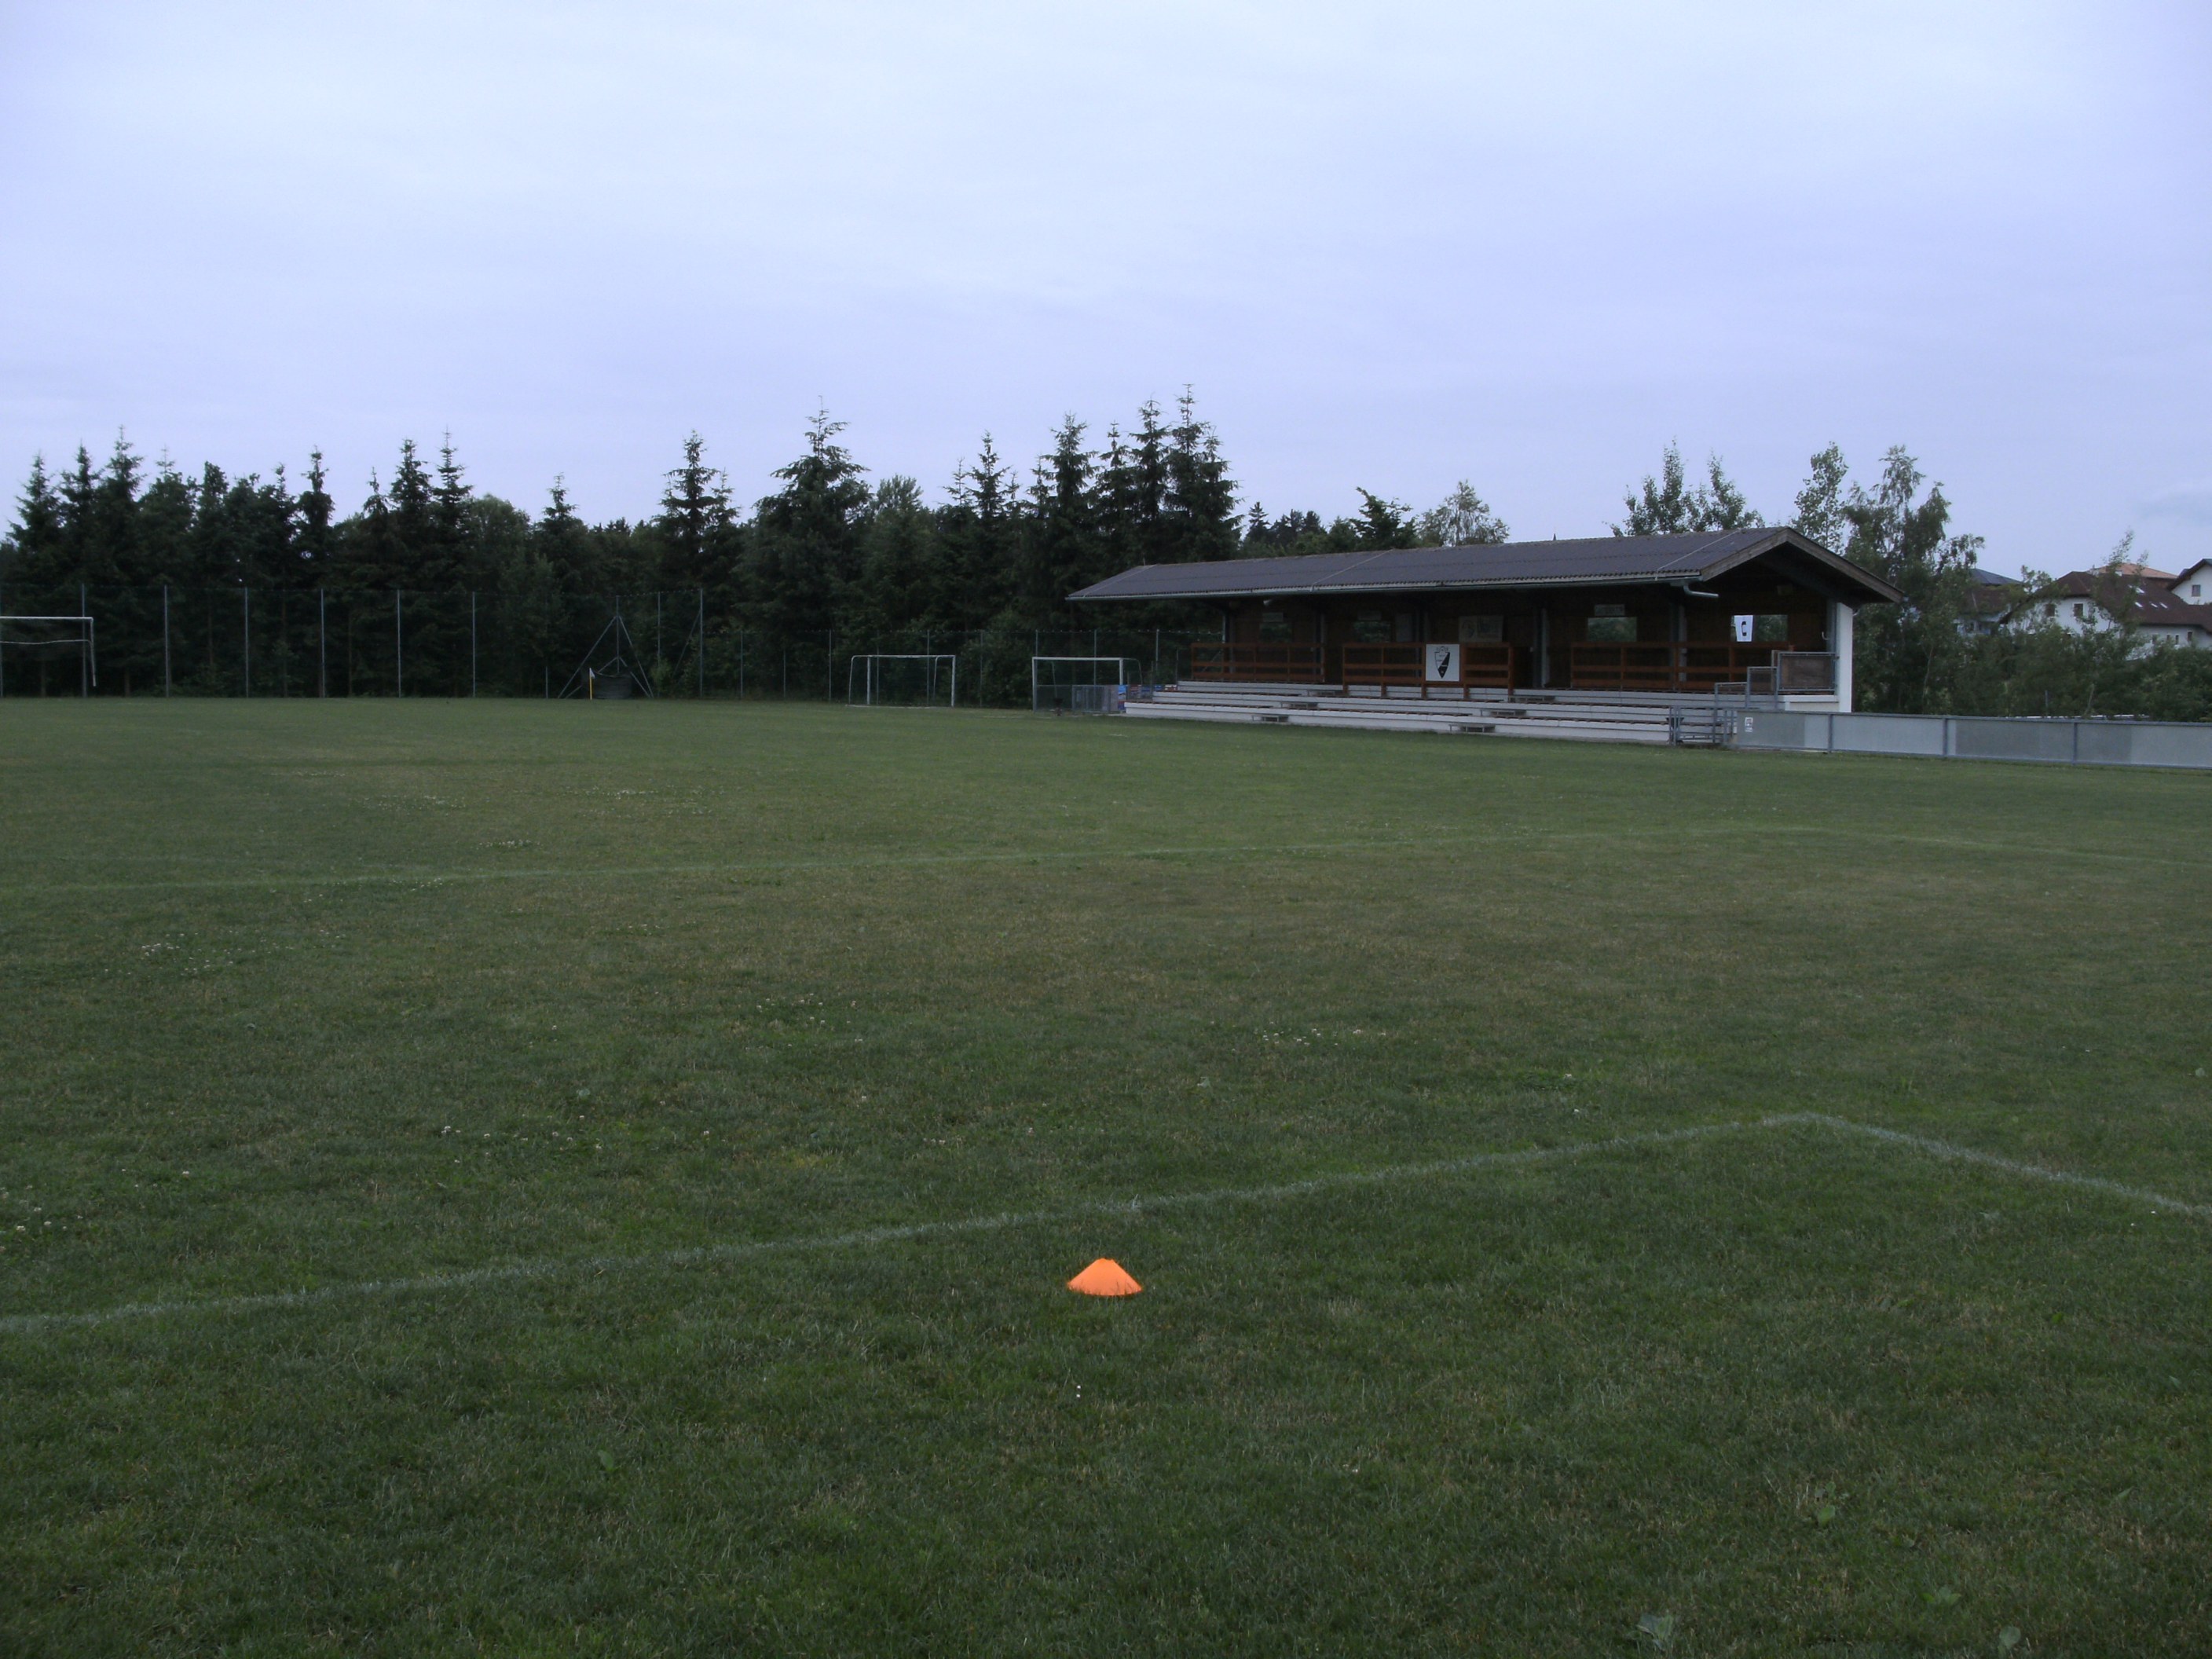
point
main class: Grassland
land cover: Grassland without tree/shrub cover
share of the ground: > 75 %
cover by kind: herbaceous plants 100 %
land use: Sport
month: June
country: AT
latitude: 48.4348
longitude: 14.1226
